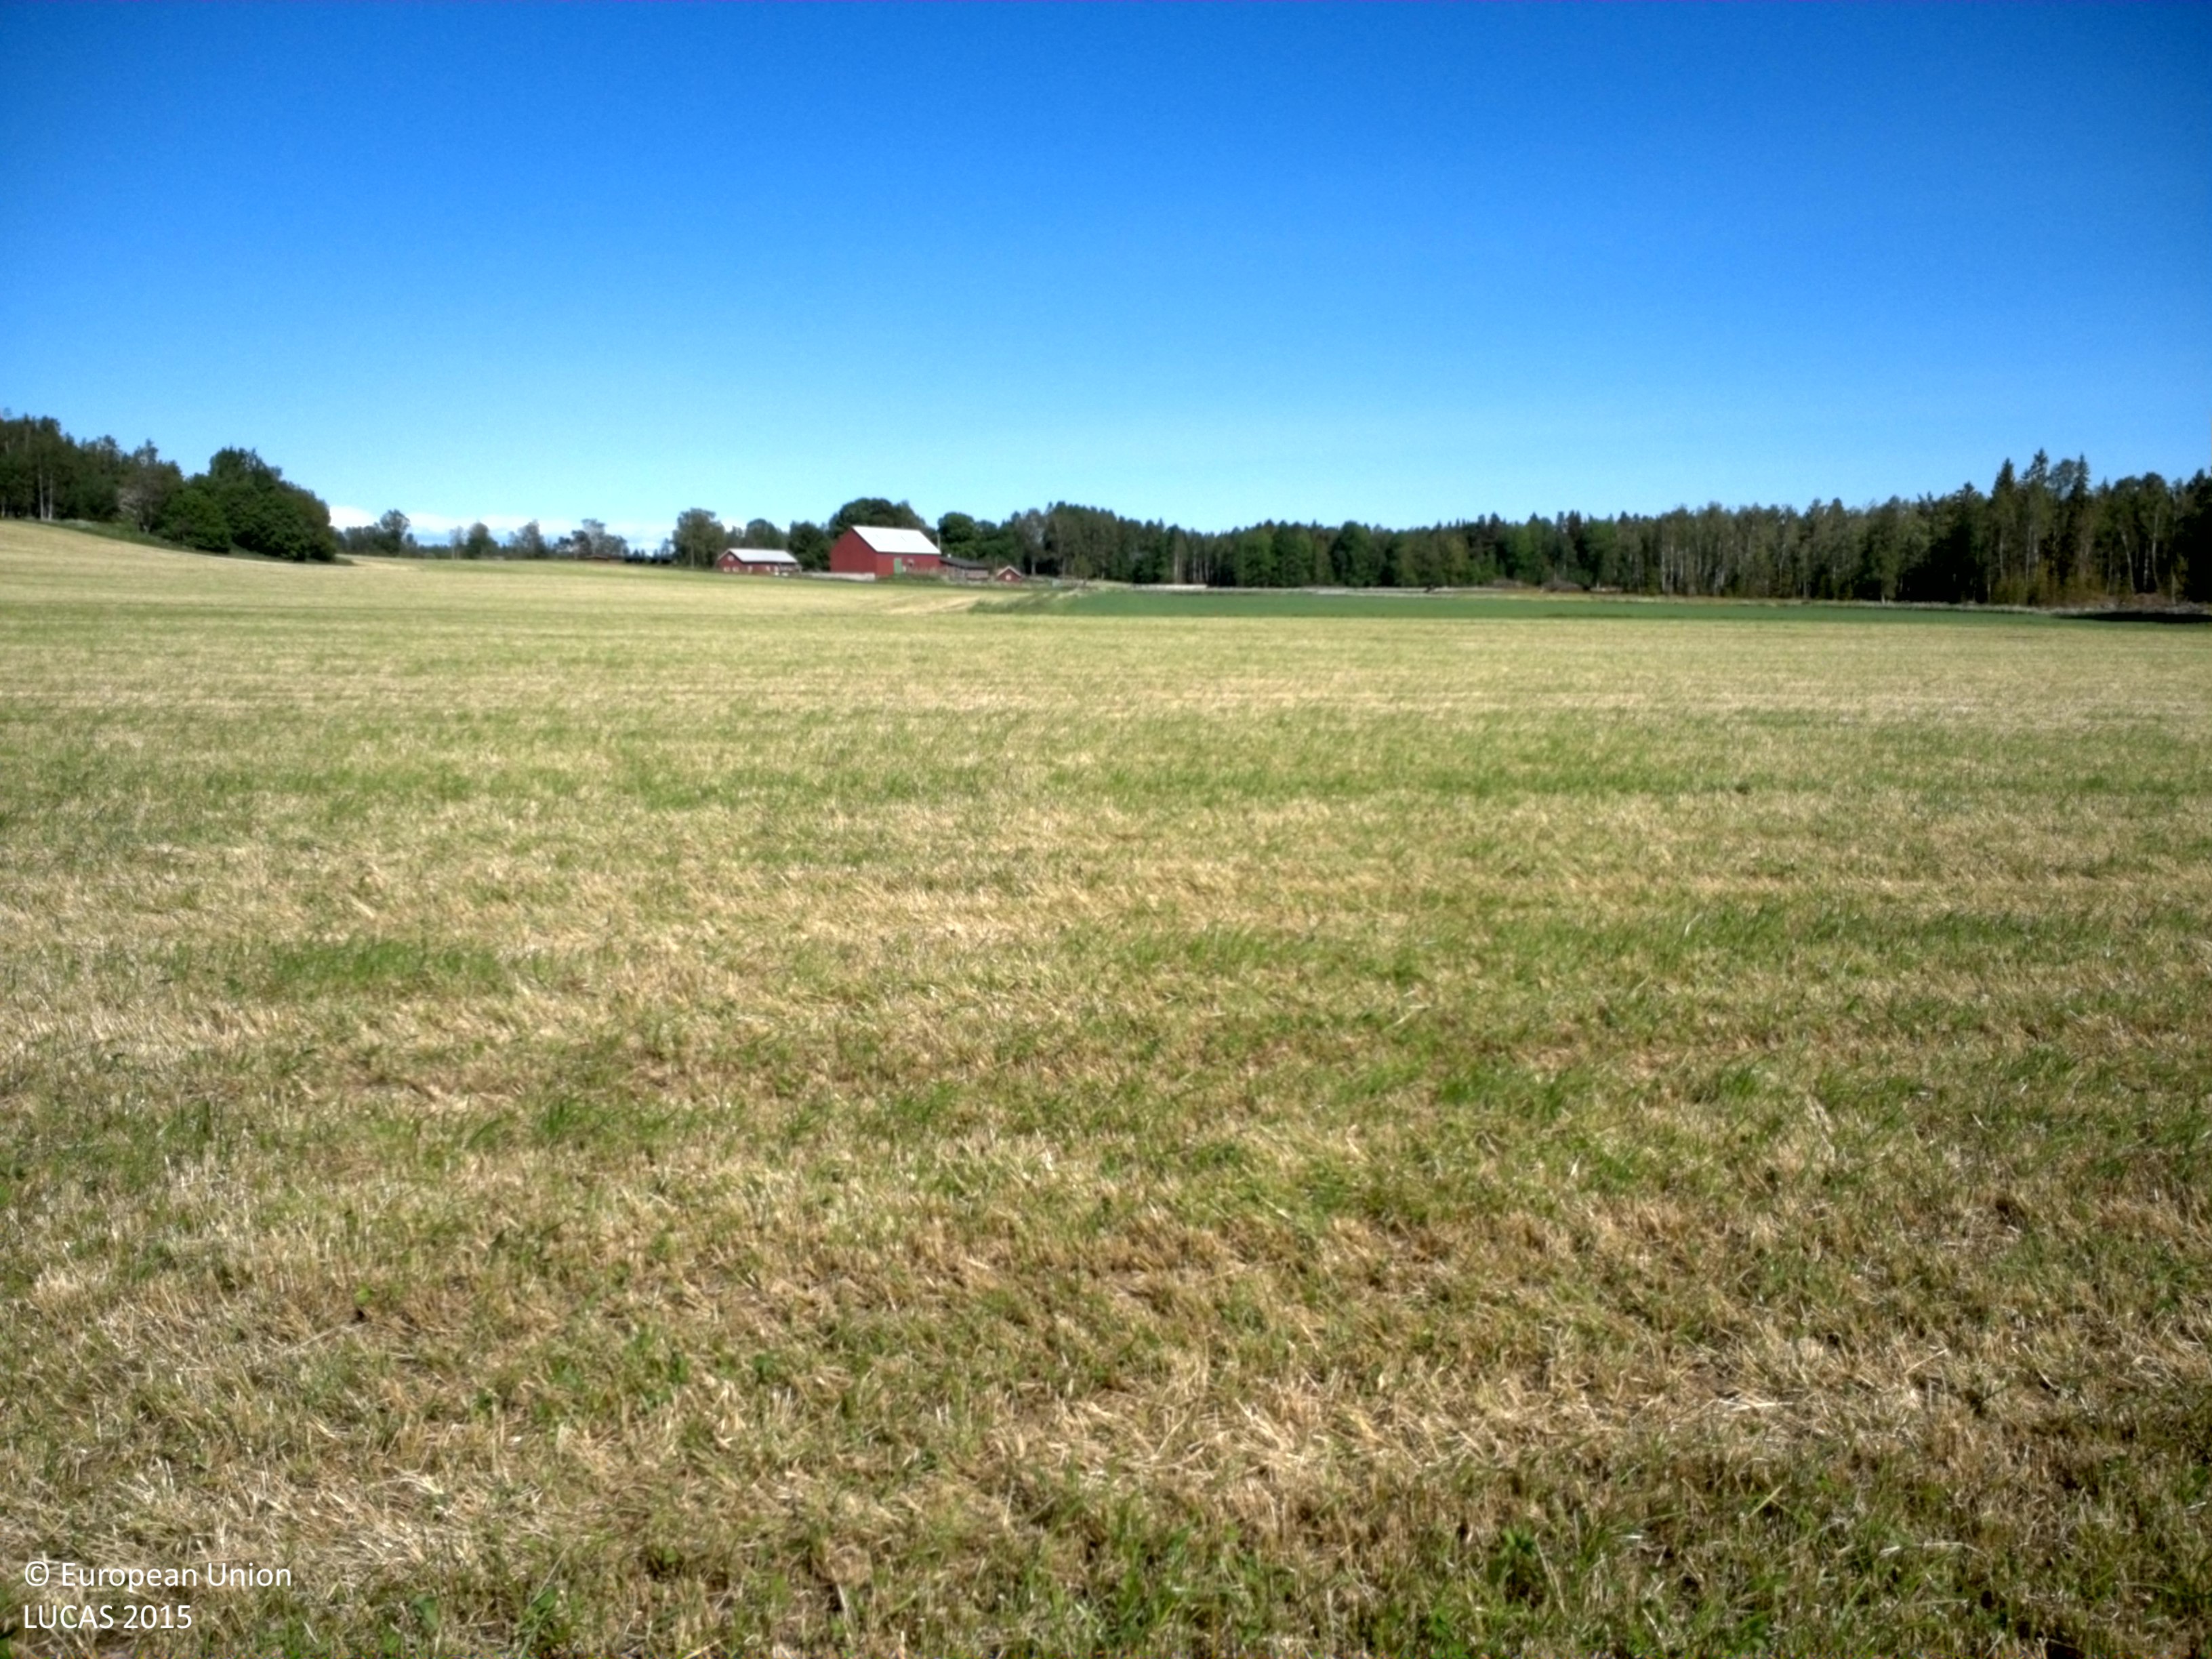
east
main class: Cropland
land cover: Other leguminous and mixtures for fodder
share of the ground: > 75 %
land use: Agriculture (excluding fallow land and kitchen gardens)
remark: Harvested field
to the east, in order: Other leguminous and mixtures for fodder; Grassland without tree/shrub cover; Other leguminous and mixtures for fodder
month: June
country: SE
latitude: 58.4297
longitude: 14.0181
